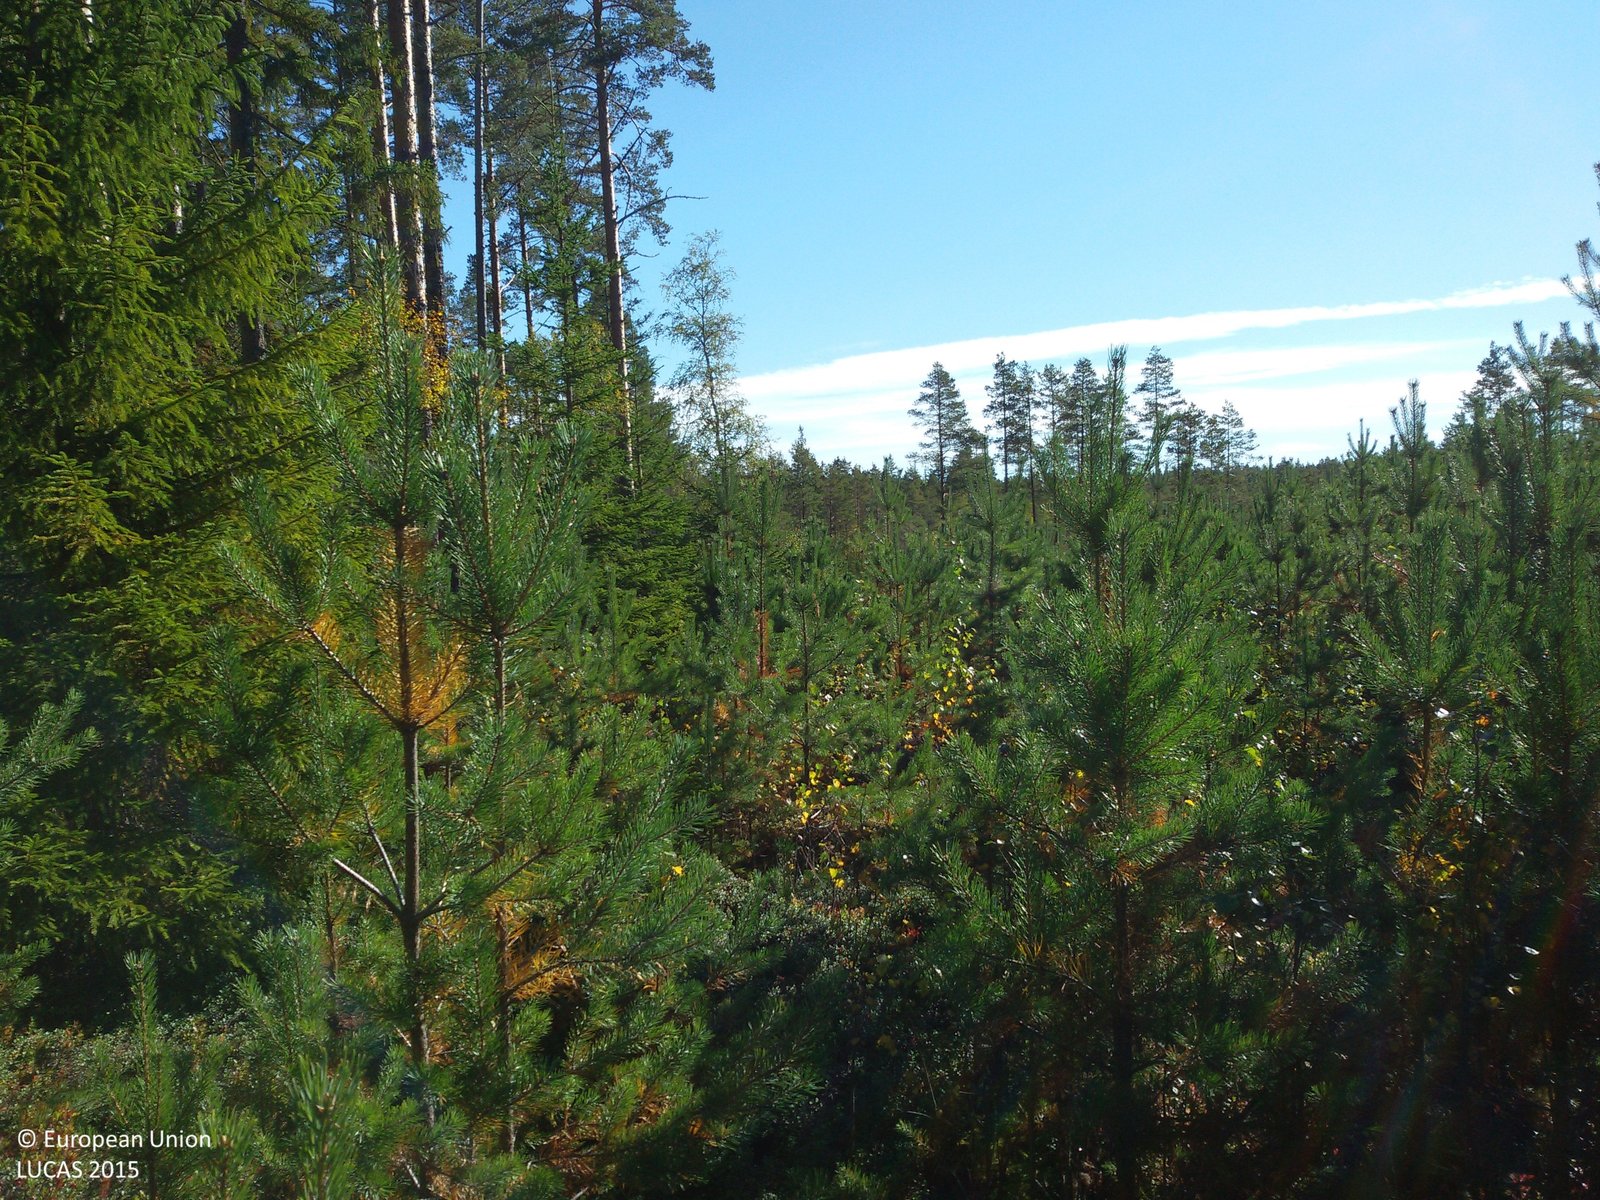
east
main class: Woodland
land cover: Pine dominated coniferous woodland
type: boreal forest
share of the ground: > 75 %
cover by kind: coniferous forest trees 90 %, shrubs 10 %
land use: Forestry
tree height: < 5 m
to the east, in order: Pine dominated coniferous woodland; Rivers and streams; Pine dominated coniferous woodland; Rivers and streams; Pine dominated coniferous woodland; Spruce dominated coniferous woodland; Pine dominated mixed woodland; Pine dominated coniferous woodland
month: September
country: SE
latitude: 60.7721
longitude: 14.6322
